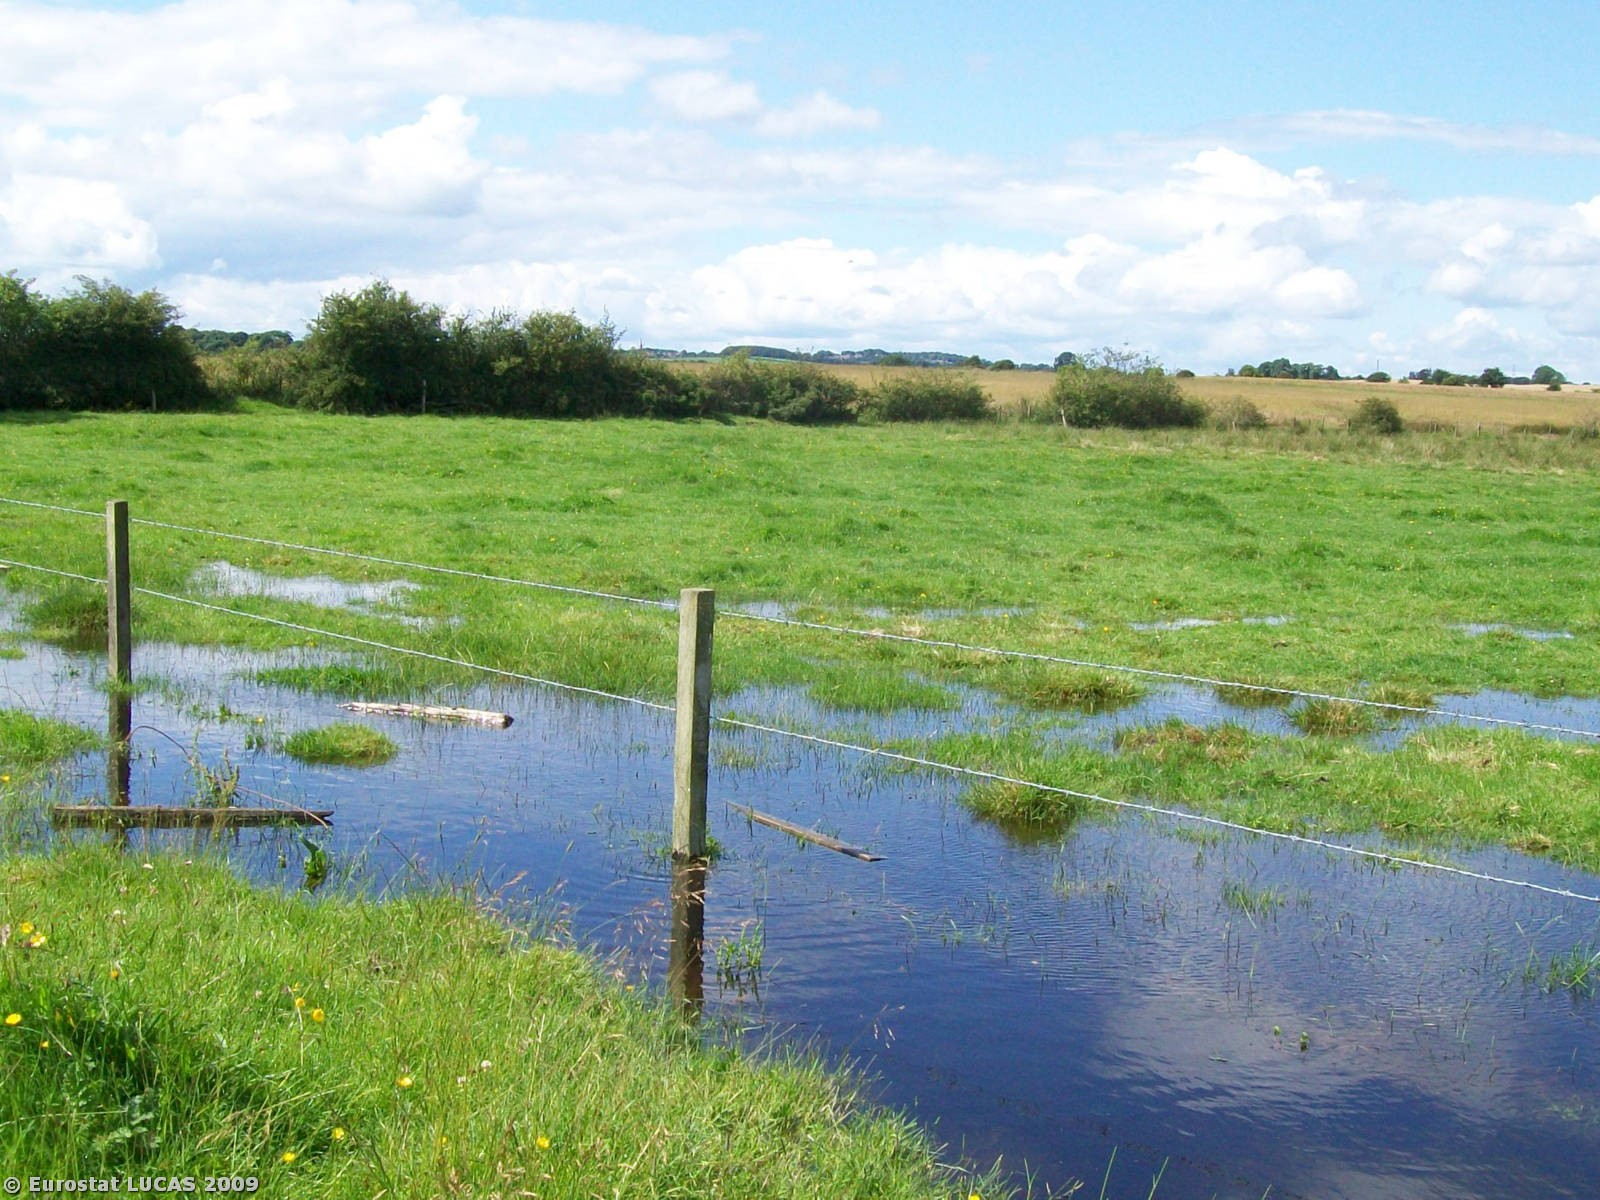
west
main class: Grassland
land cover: Grassland without tree/shrub cover
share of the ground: > 75 %
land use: Agriculture (excluding fallow land and kitchen gardens)
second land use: Nature reserves
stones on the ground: < 10 %
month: July
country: GB
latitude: 55.0109
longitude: -1.7315
